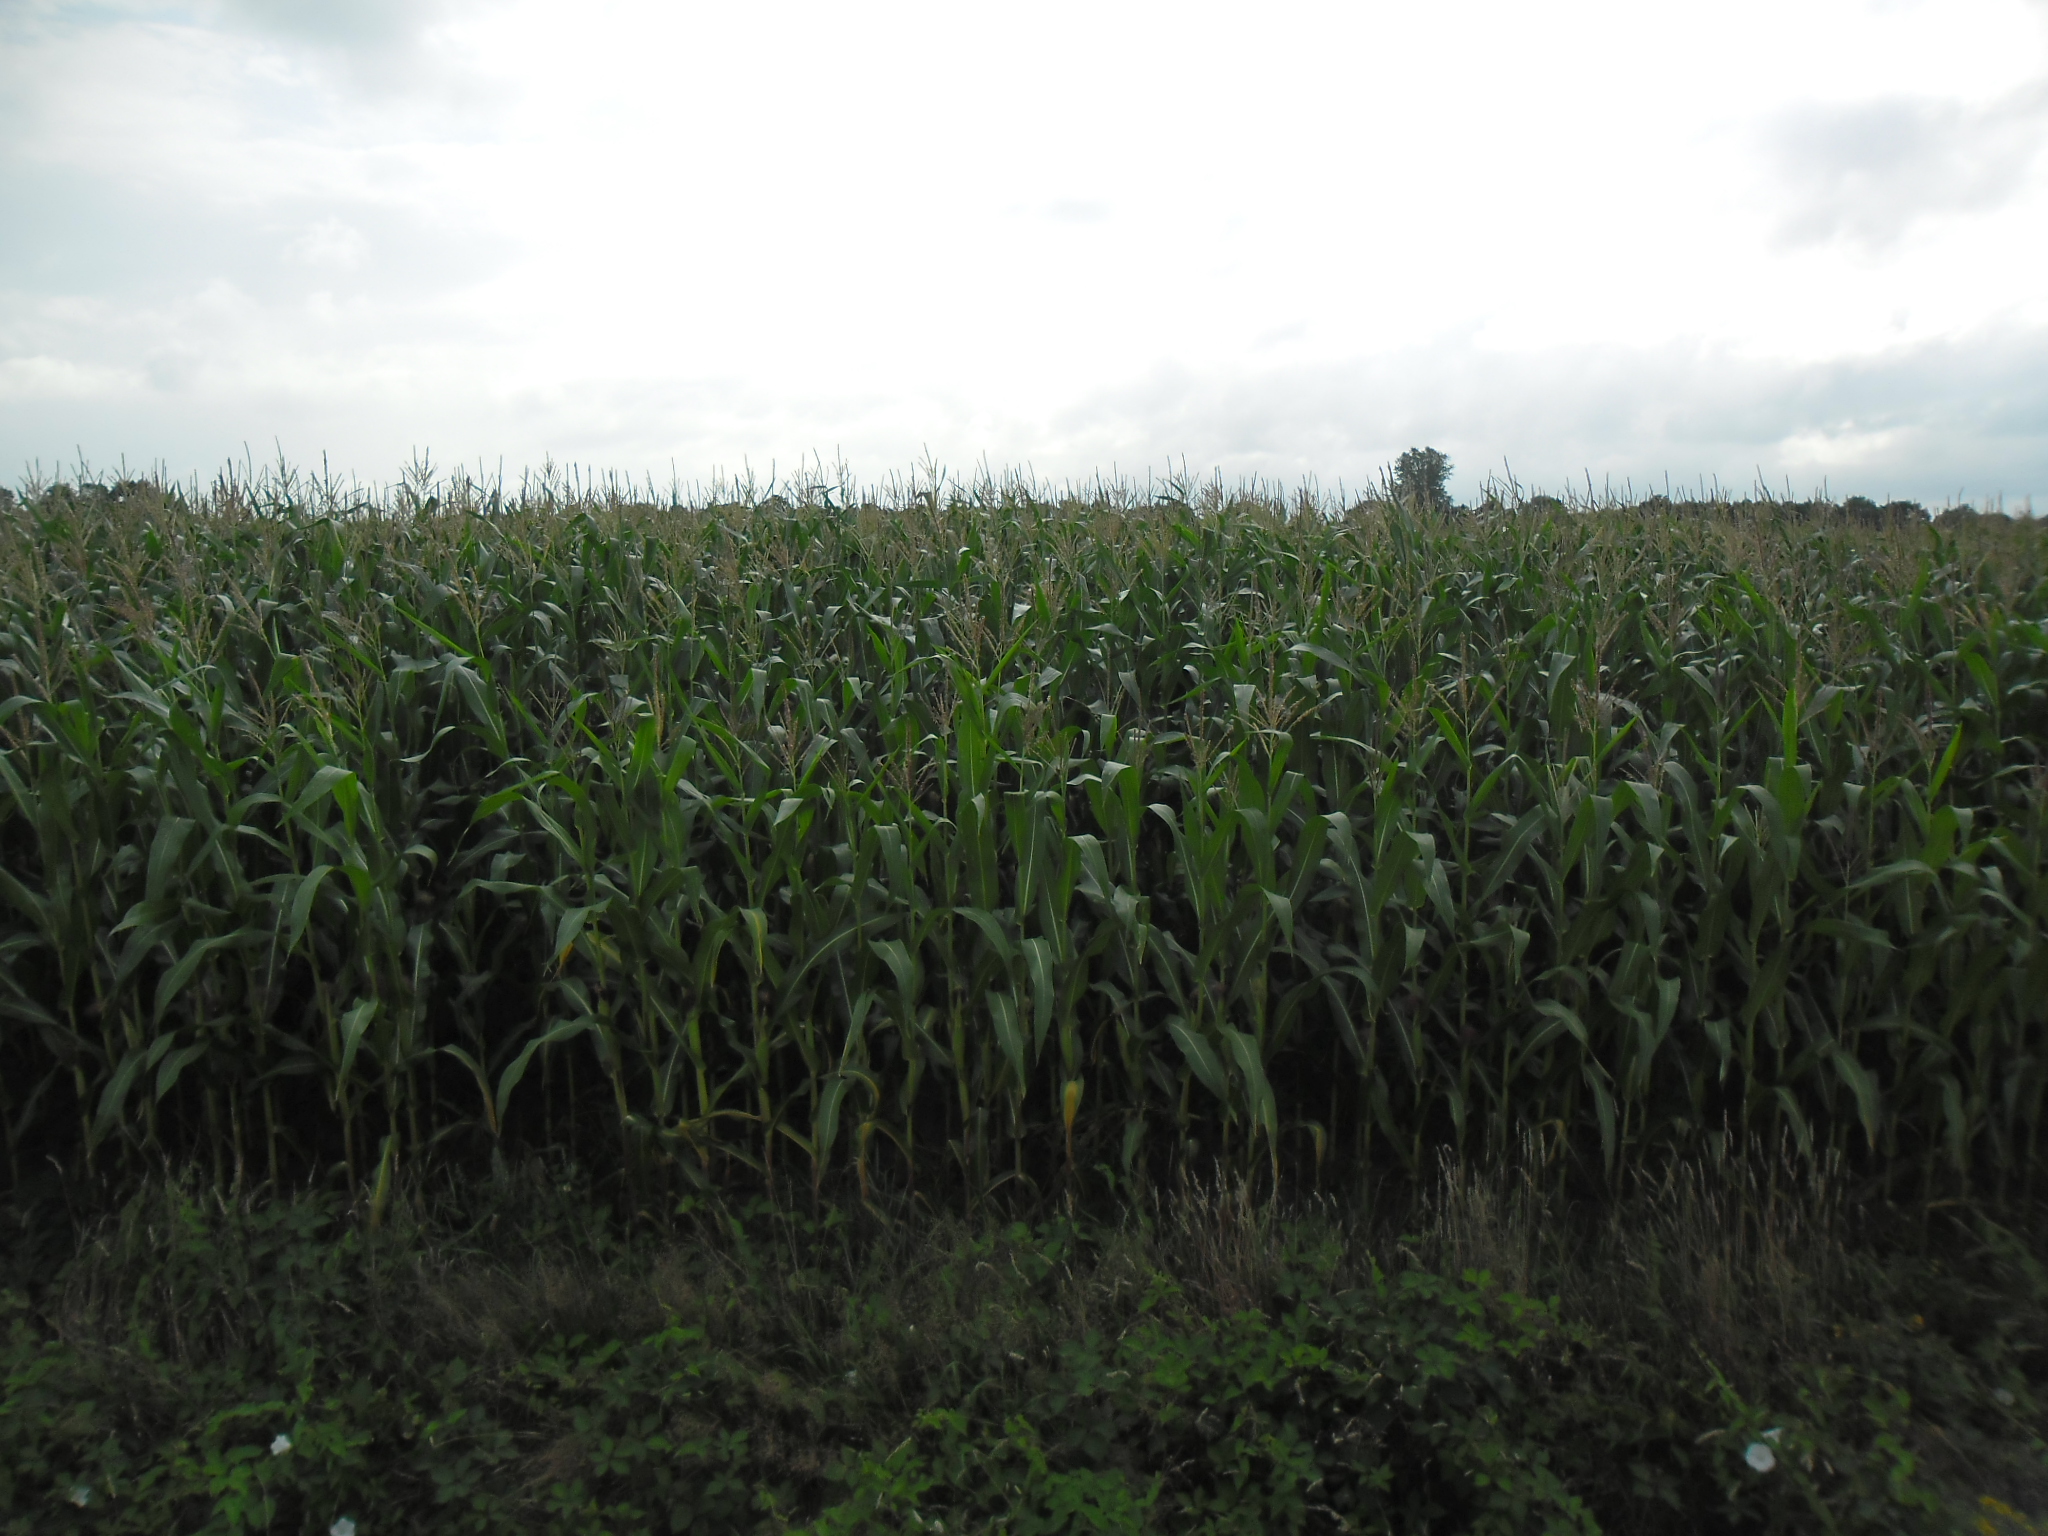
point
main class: Cropland
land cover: Maize
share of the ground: > 75 %
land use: Agriculture (excluding fallow land and kitchen gardens)
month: August
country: NL
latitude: 52.8895
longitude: 5.5845
